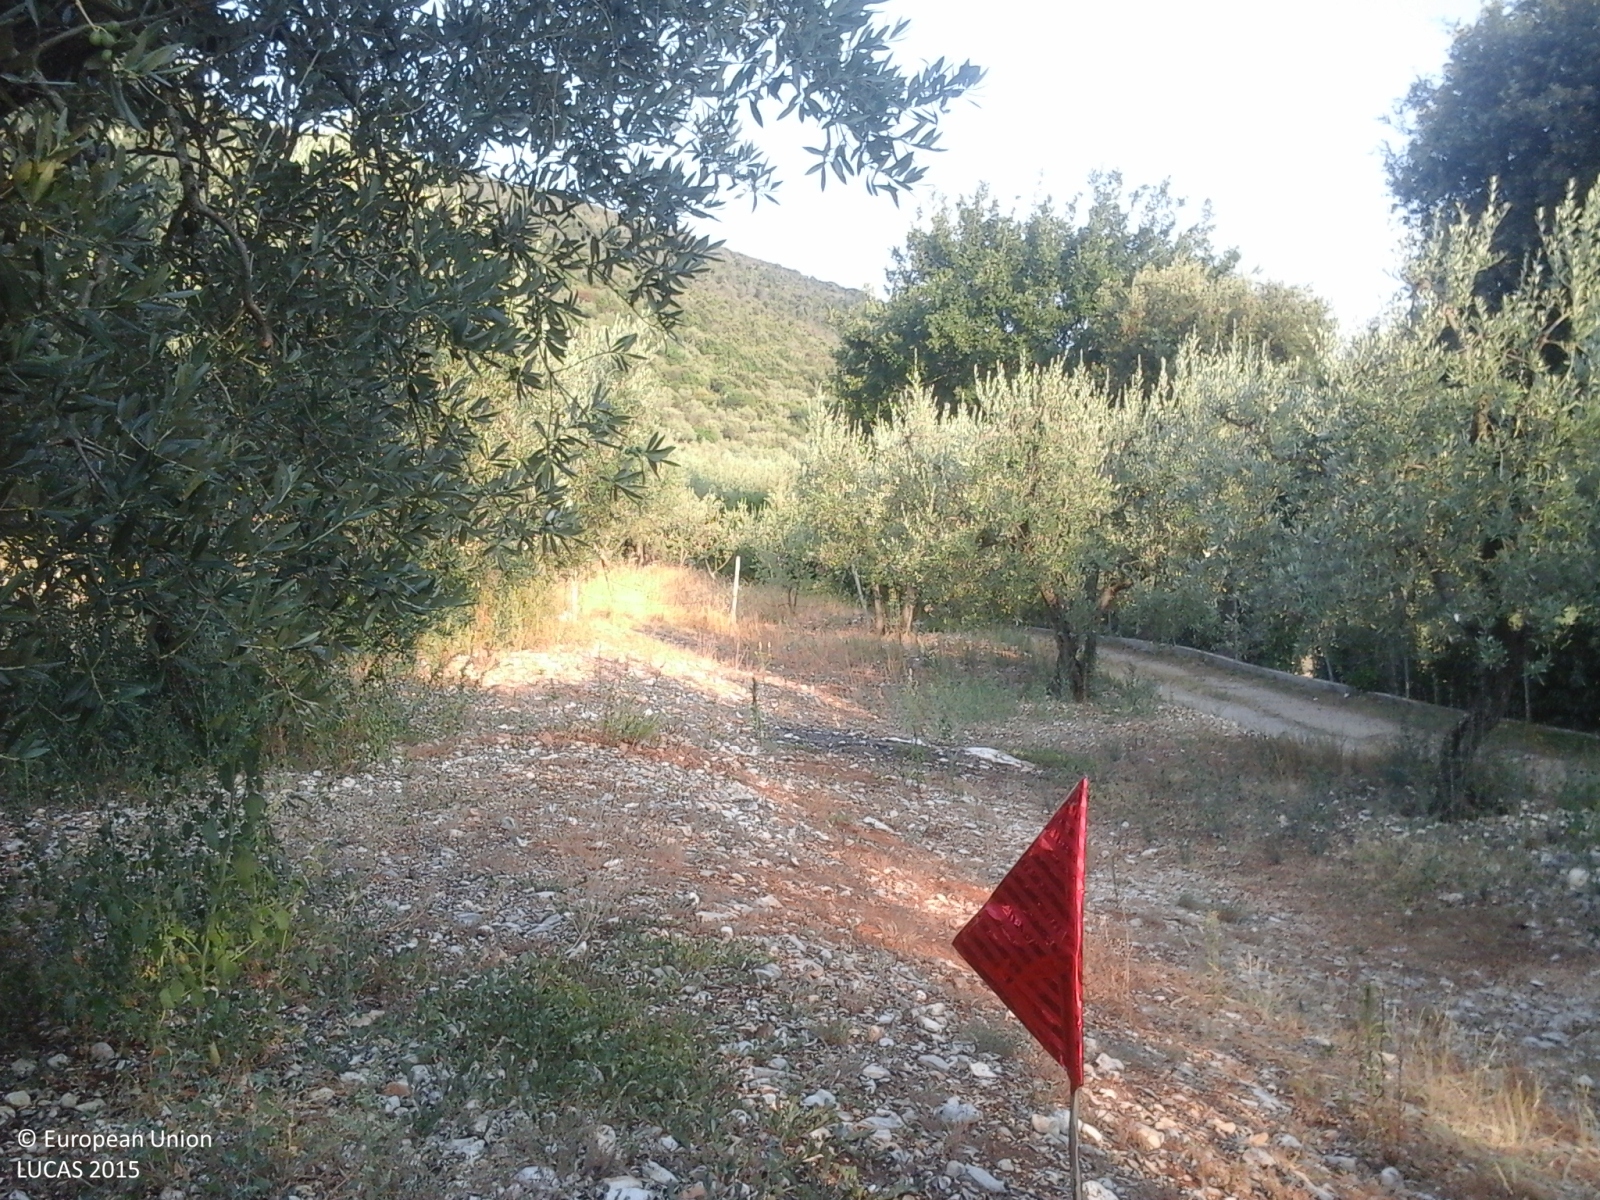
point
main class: Cropland
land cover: Olive groves
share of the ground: 50 - 75 %
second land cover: Spontaneously vegetated surfaces
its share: 25 - 50 %
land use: Agriculture (excluding fallow land and kitchen gardens)
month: August
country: IT
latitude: 42.5727
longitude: 12.3436
